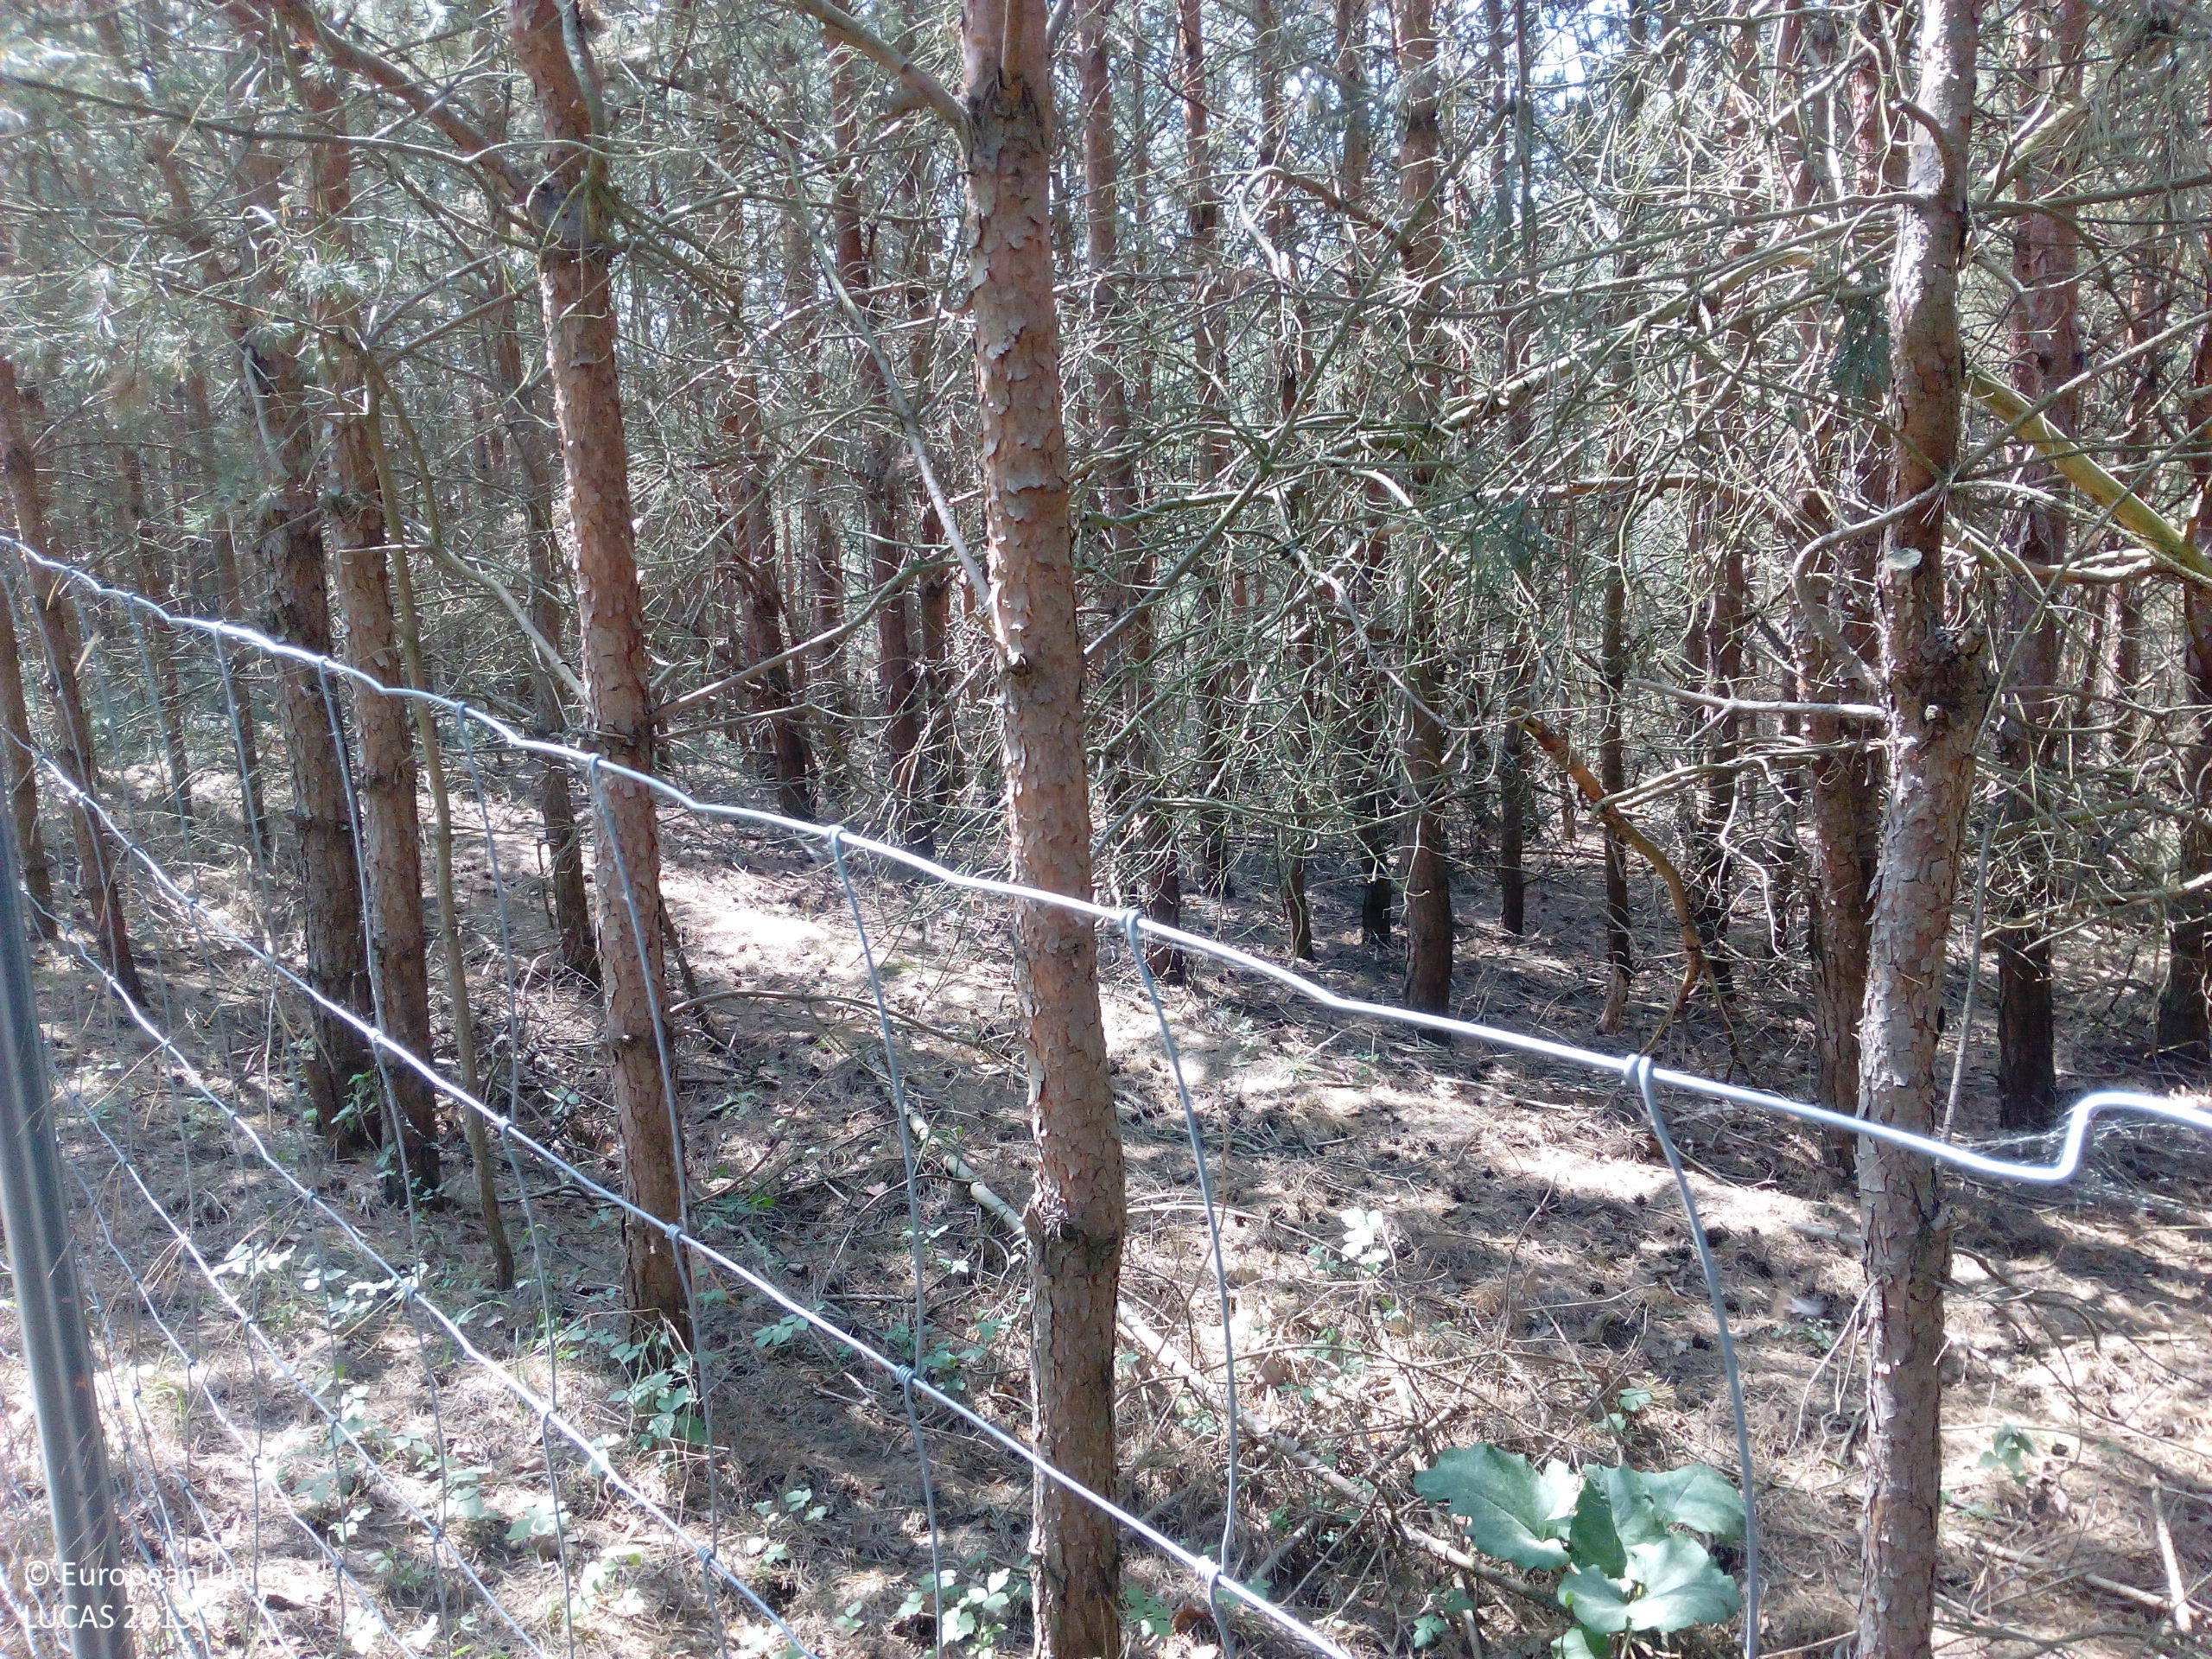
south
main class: Woodland
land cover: Pine dominated mixed woodland
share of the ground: > 75 %
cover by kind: coniferous forest trees 50 %, broadleaved forest trees 50 %
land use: Forestry
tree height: > 5 m
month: May
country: DE
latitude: 51.6343
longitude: 12.3836
